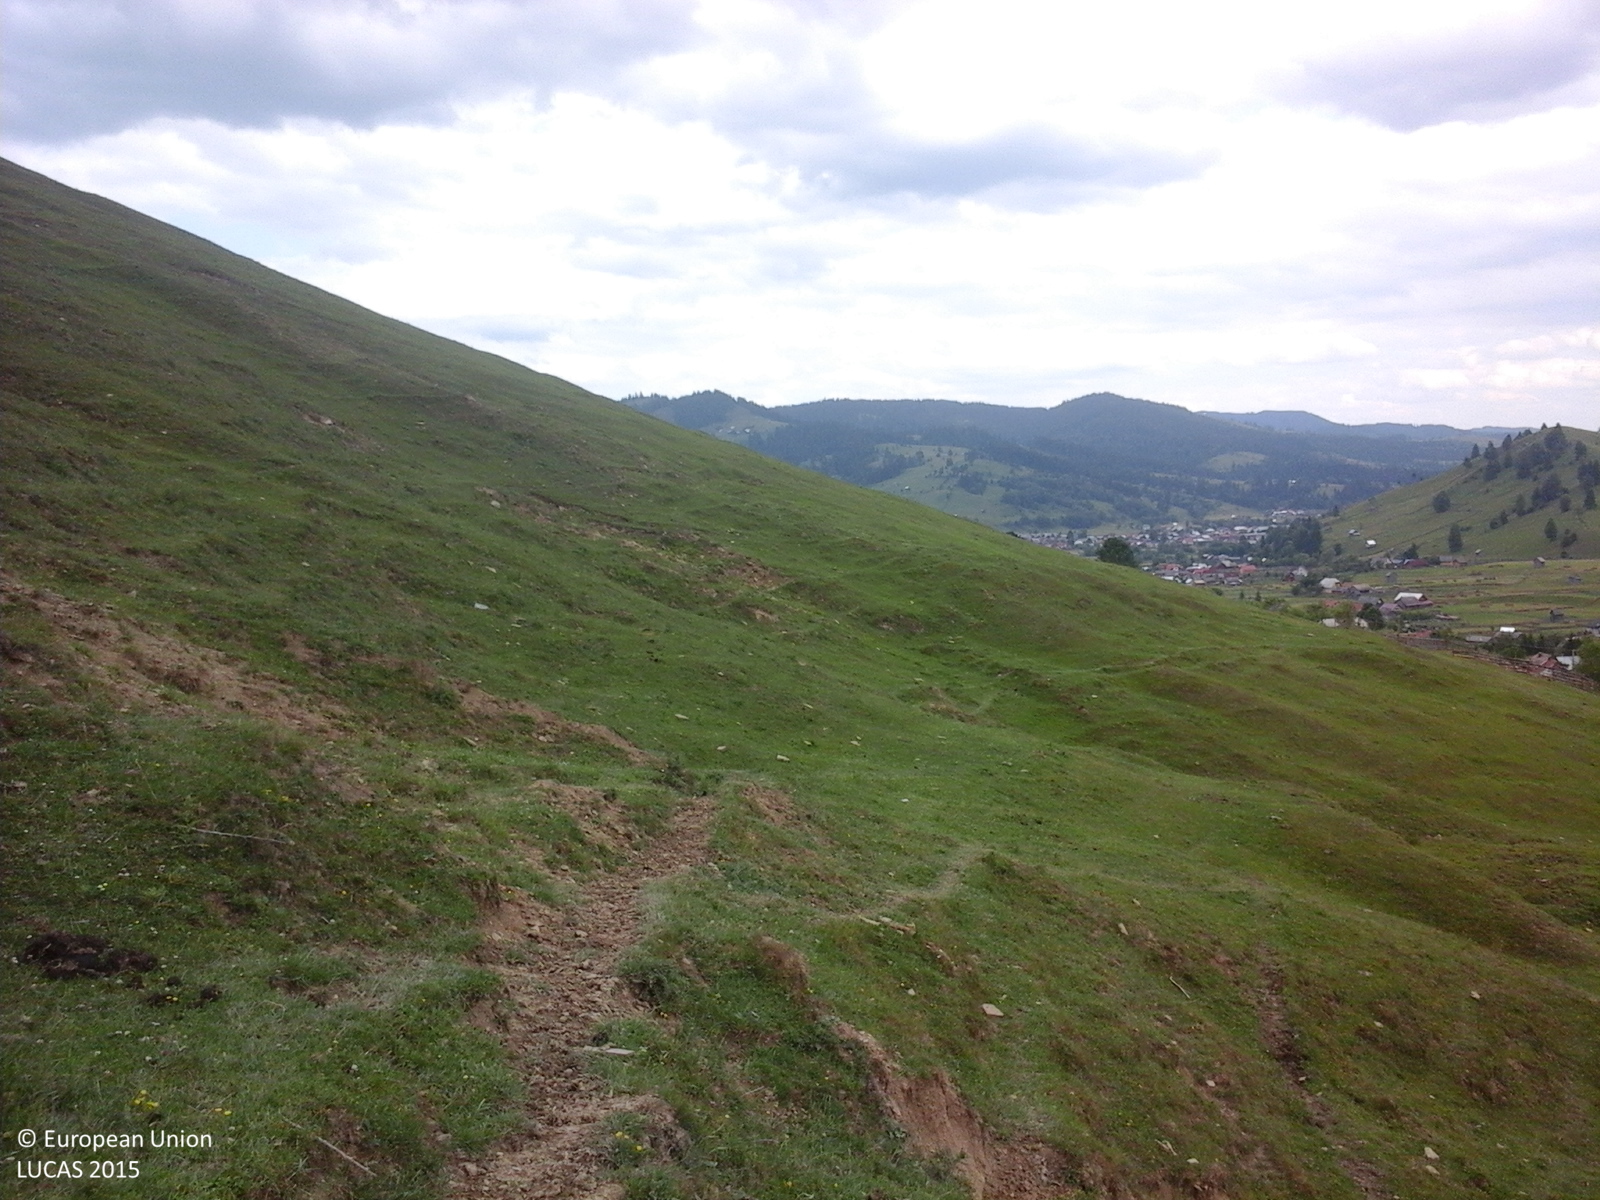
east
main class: Grassland
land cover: Grassland without tree/shrub cover
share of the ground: > 75 %
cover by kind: herbaceous plants 100 %
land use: Agriculture (excluding fallow land and kitchen gardens)
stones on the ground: < 10 %
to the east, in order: Grassland without tree/shrub cover
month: June
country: RO
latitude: 47.7034
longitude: 25.5100
